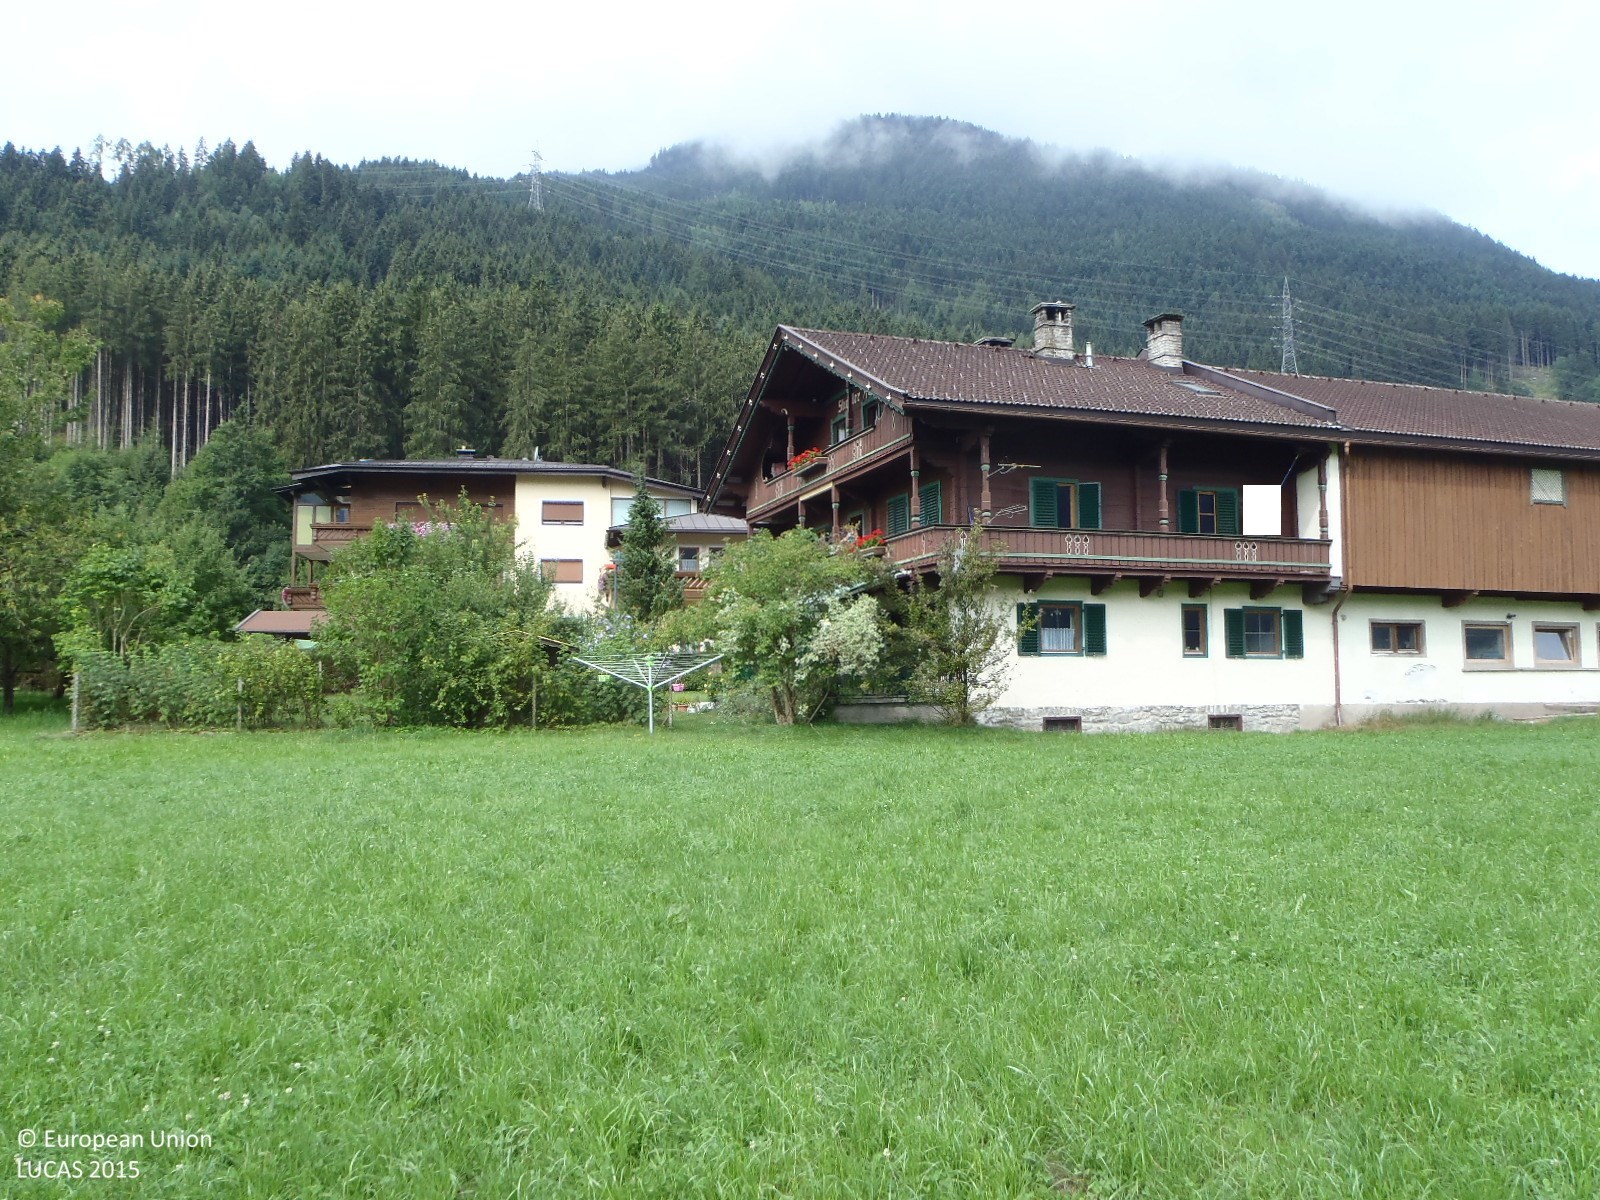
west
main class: Grassland
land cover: Grassland without tree/shrub cover
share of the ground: > 75 %
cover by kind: herbaceous plants 100 %
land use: Agriculture (excluding fallow land and kitchen gardens)
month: July
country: AT
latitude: 47.3076
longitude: 11.8635
